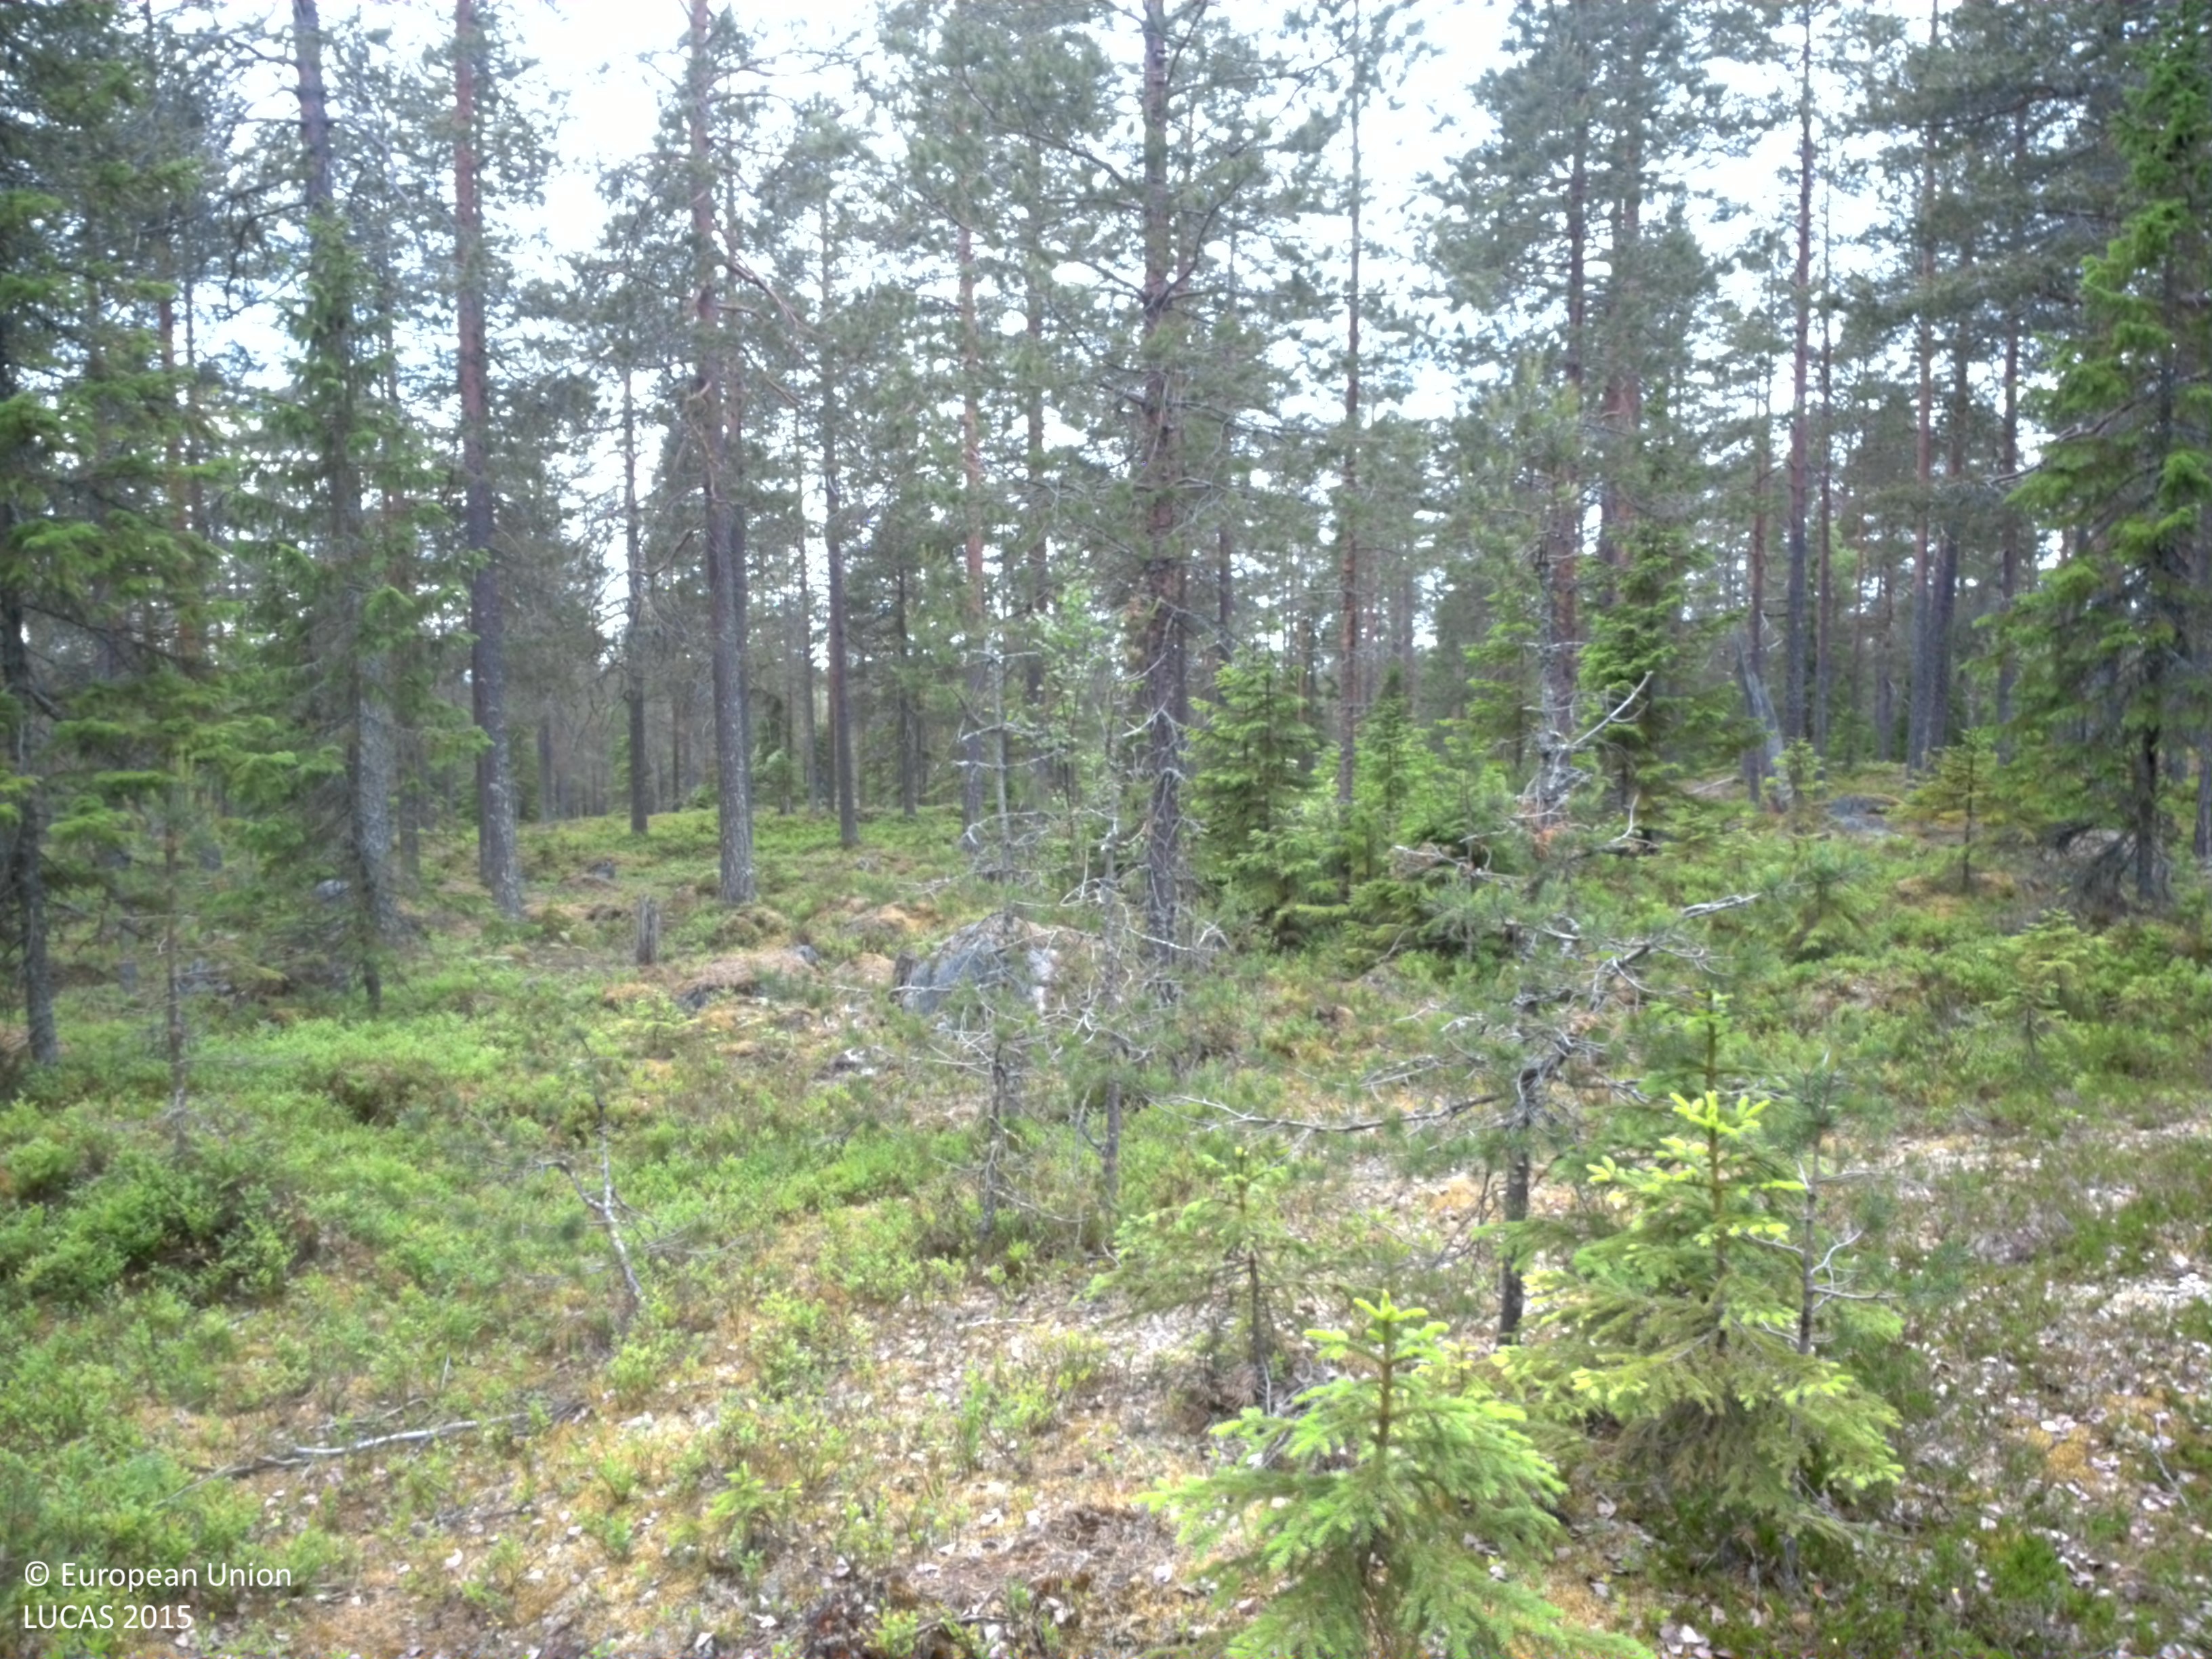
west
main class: Woodland
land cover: Other coniferous woodland
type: boreal forest
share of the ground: 25 - 50 %
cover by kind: coniferous forest trees 50 %, shrubs 45 %, lichens and mosses 5 %
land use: Forestry
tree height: > 5 m
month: July
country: SE
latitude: 64.3744
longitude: 20.8191
